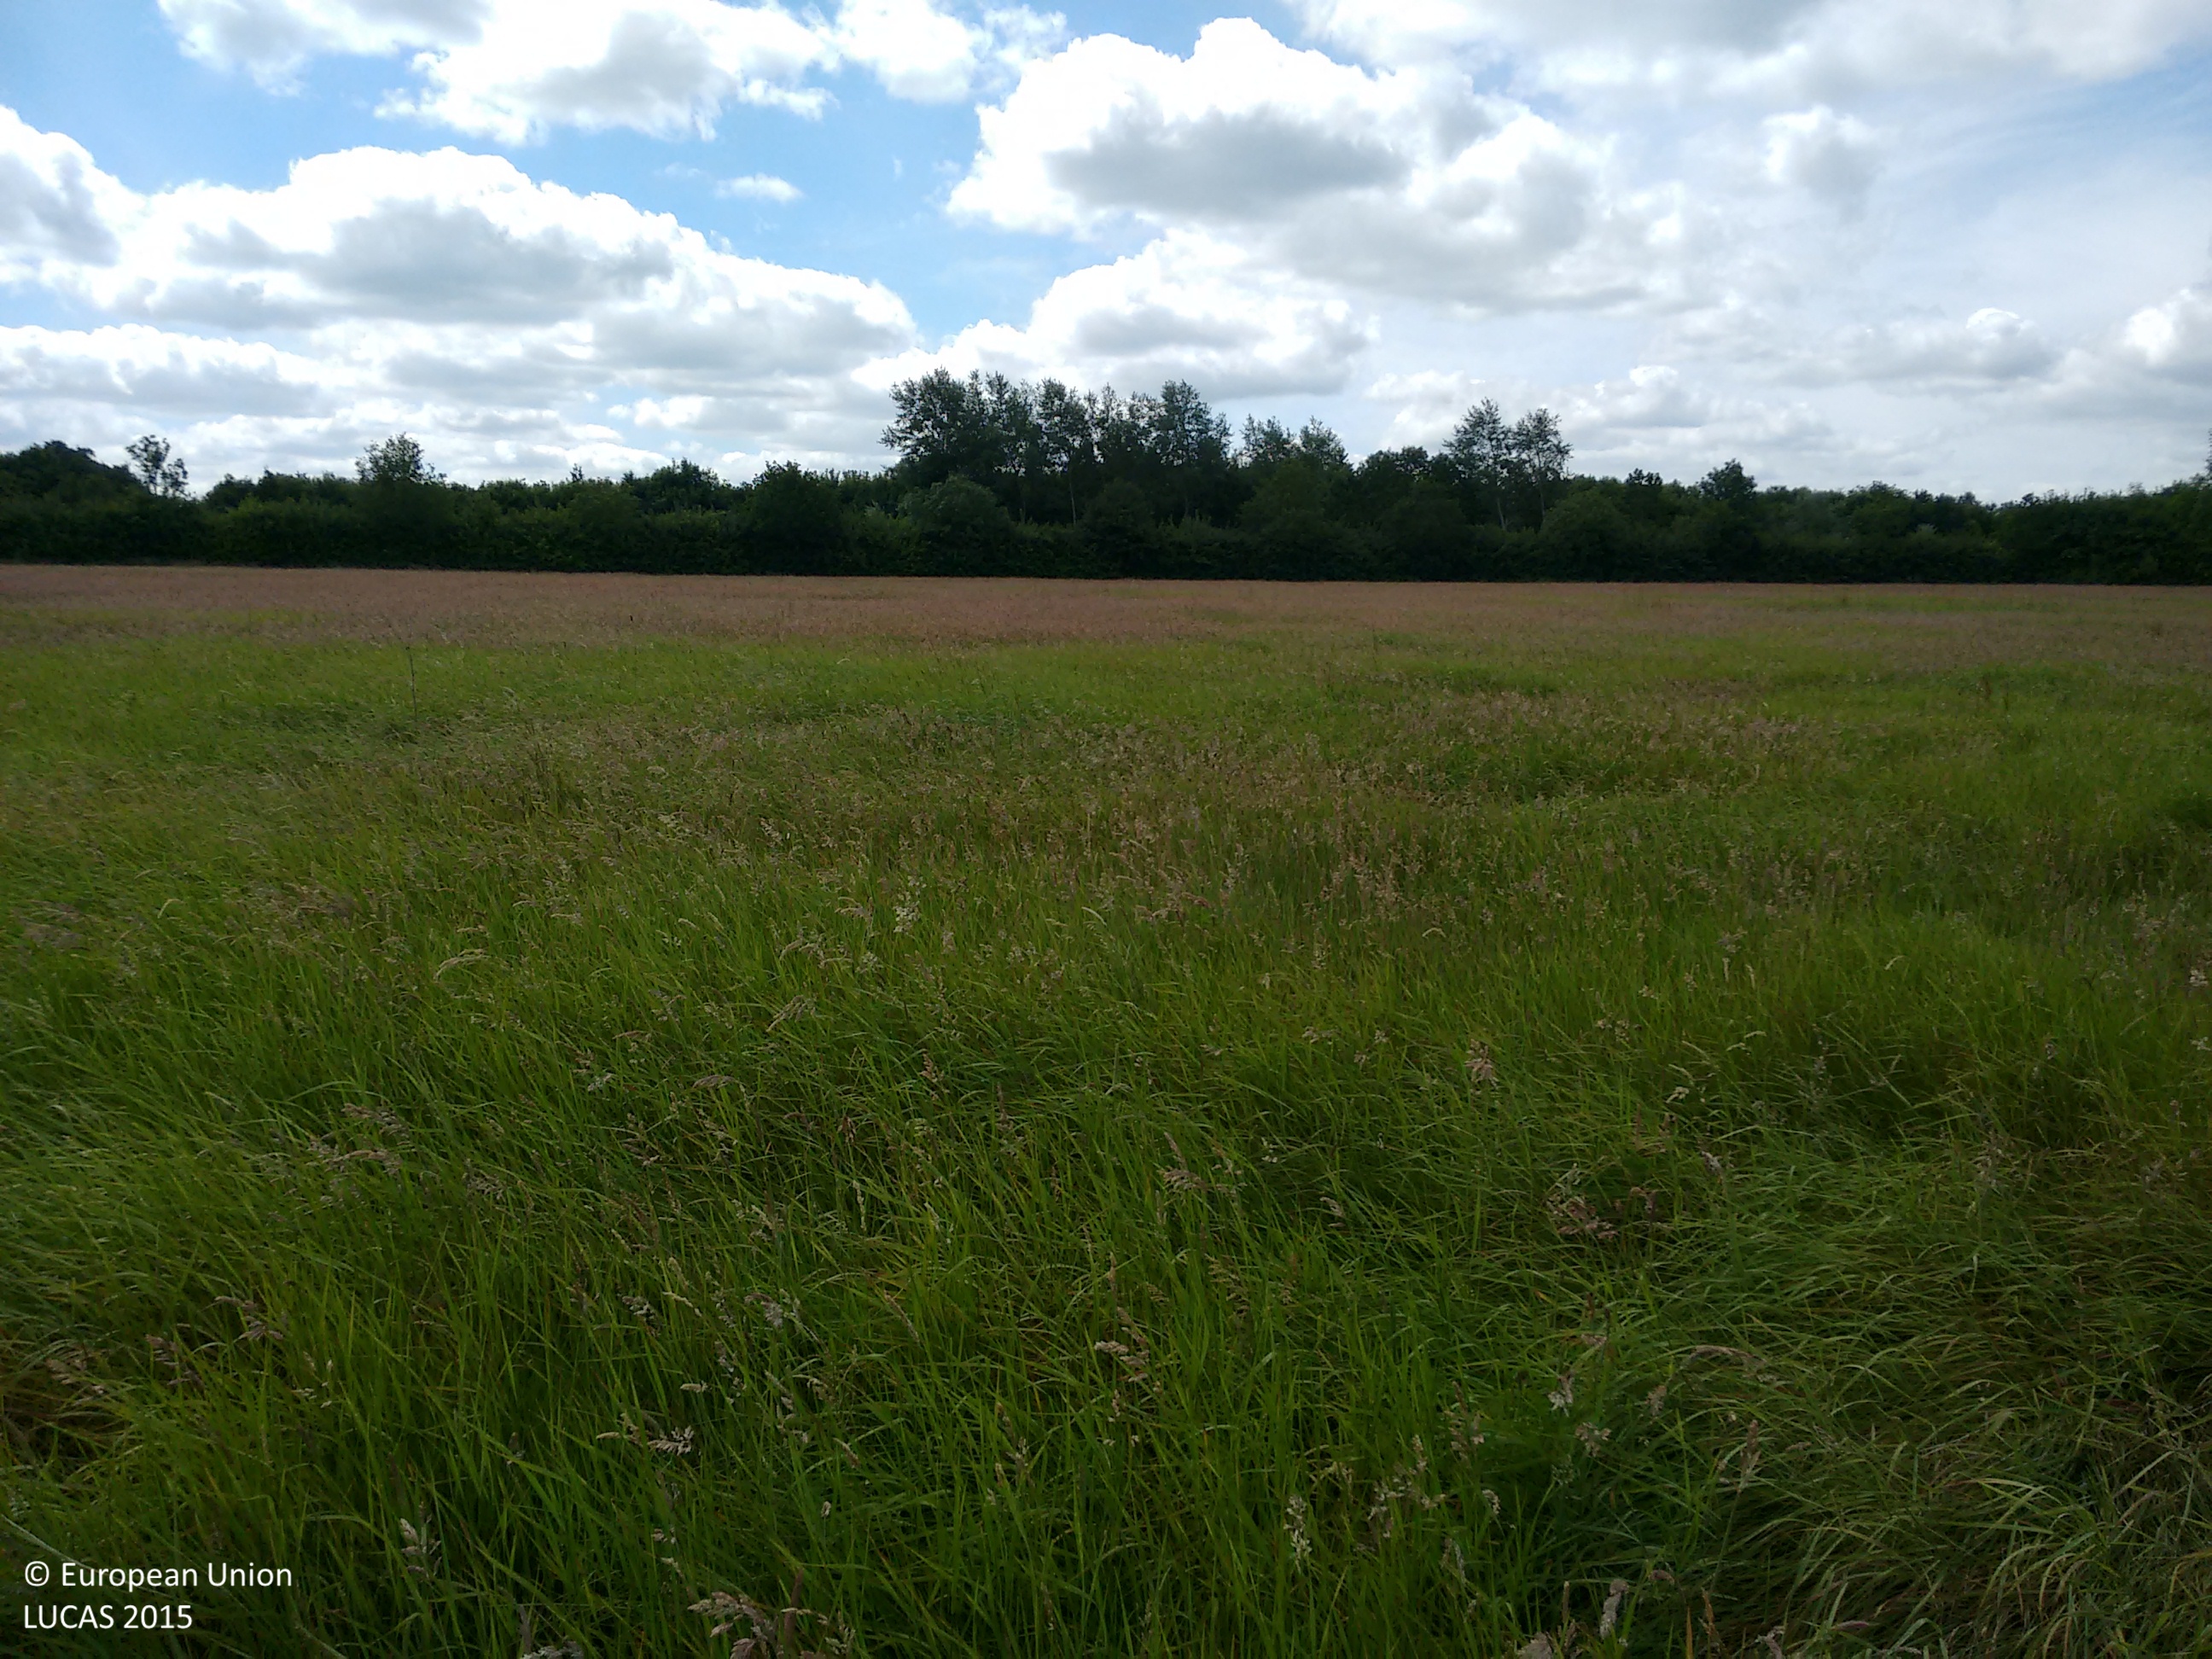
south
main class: Grassland
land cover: Grassland without tree/shrub cover
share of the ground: > 75 %
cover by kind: herbaceous plants 100 %
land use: Agriculture (excluding fallow land and kitchen gardens)
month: June
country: GB
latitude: 51.6134
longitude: -1.5326
